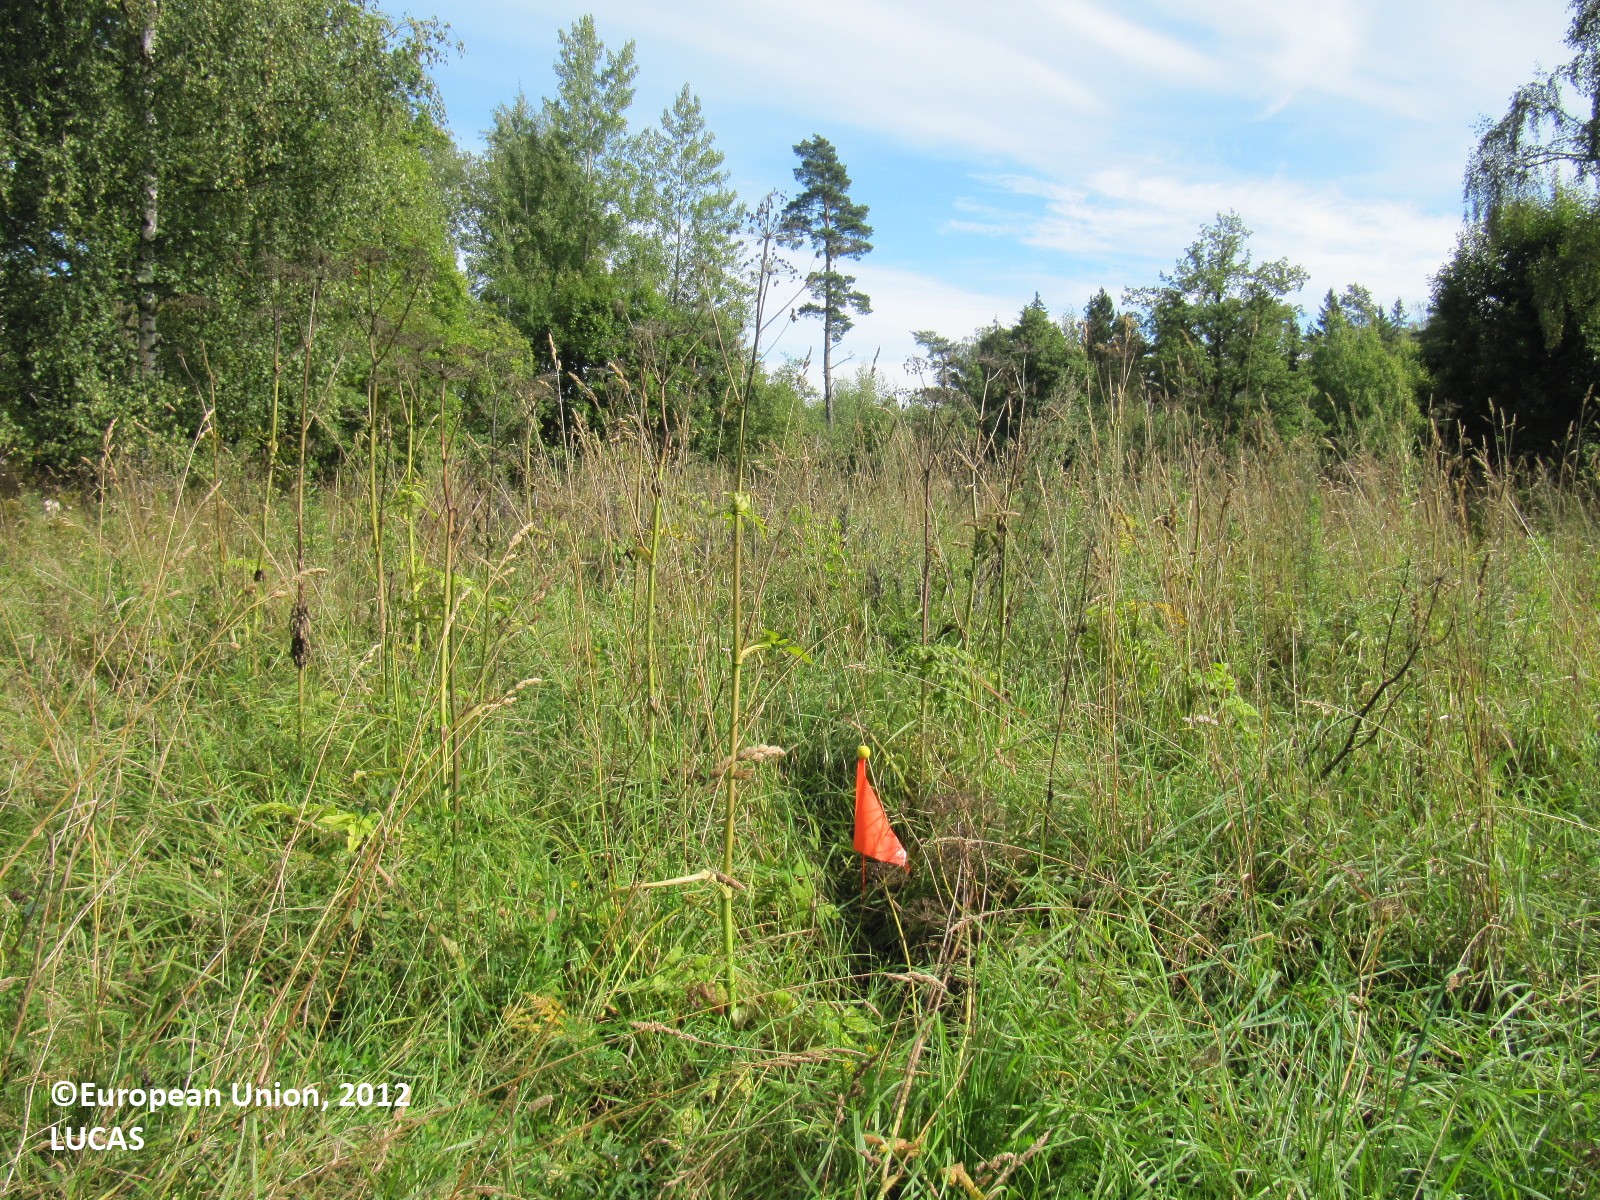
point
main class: Grassland
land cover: Spontaneously vegetated surfaces
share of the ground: > 75 %
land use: Fallow land
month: August
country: FI
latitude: 60.2237
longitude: 23.8693
